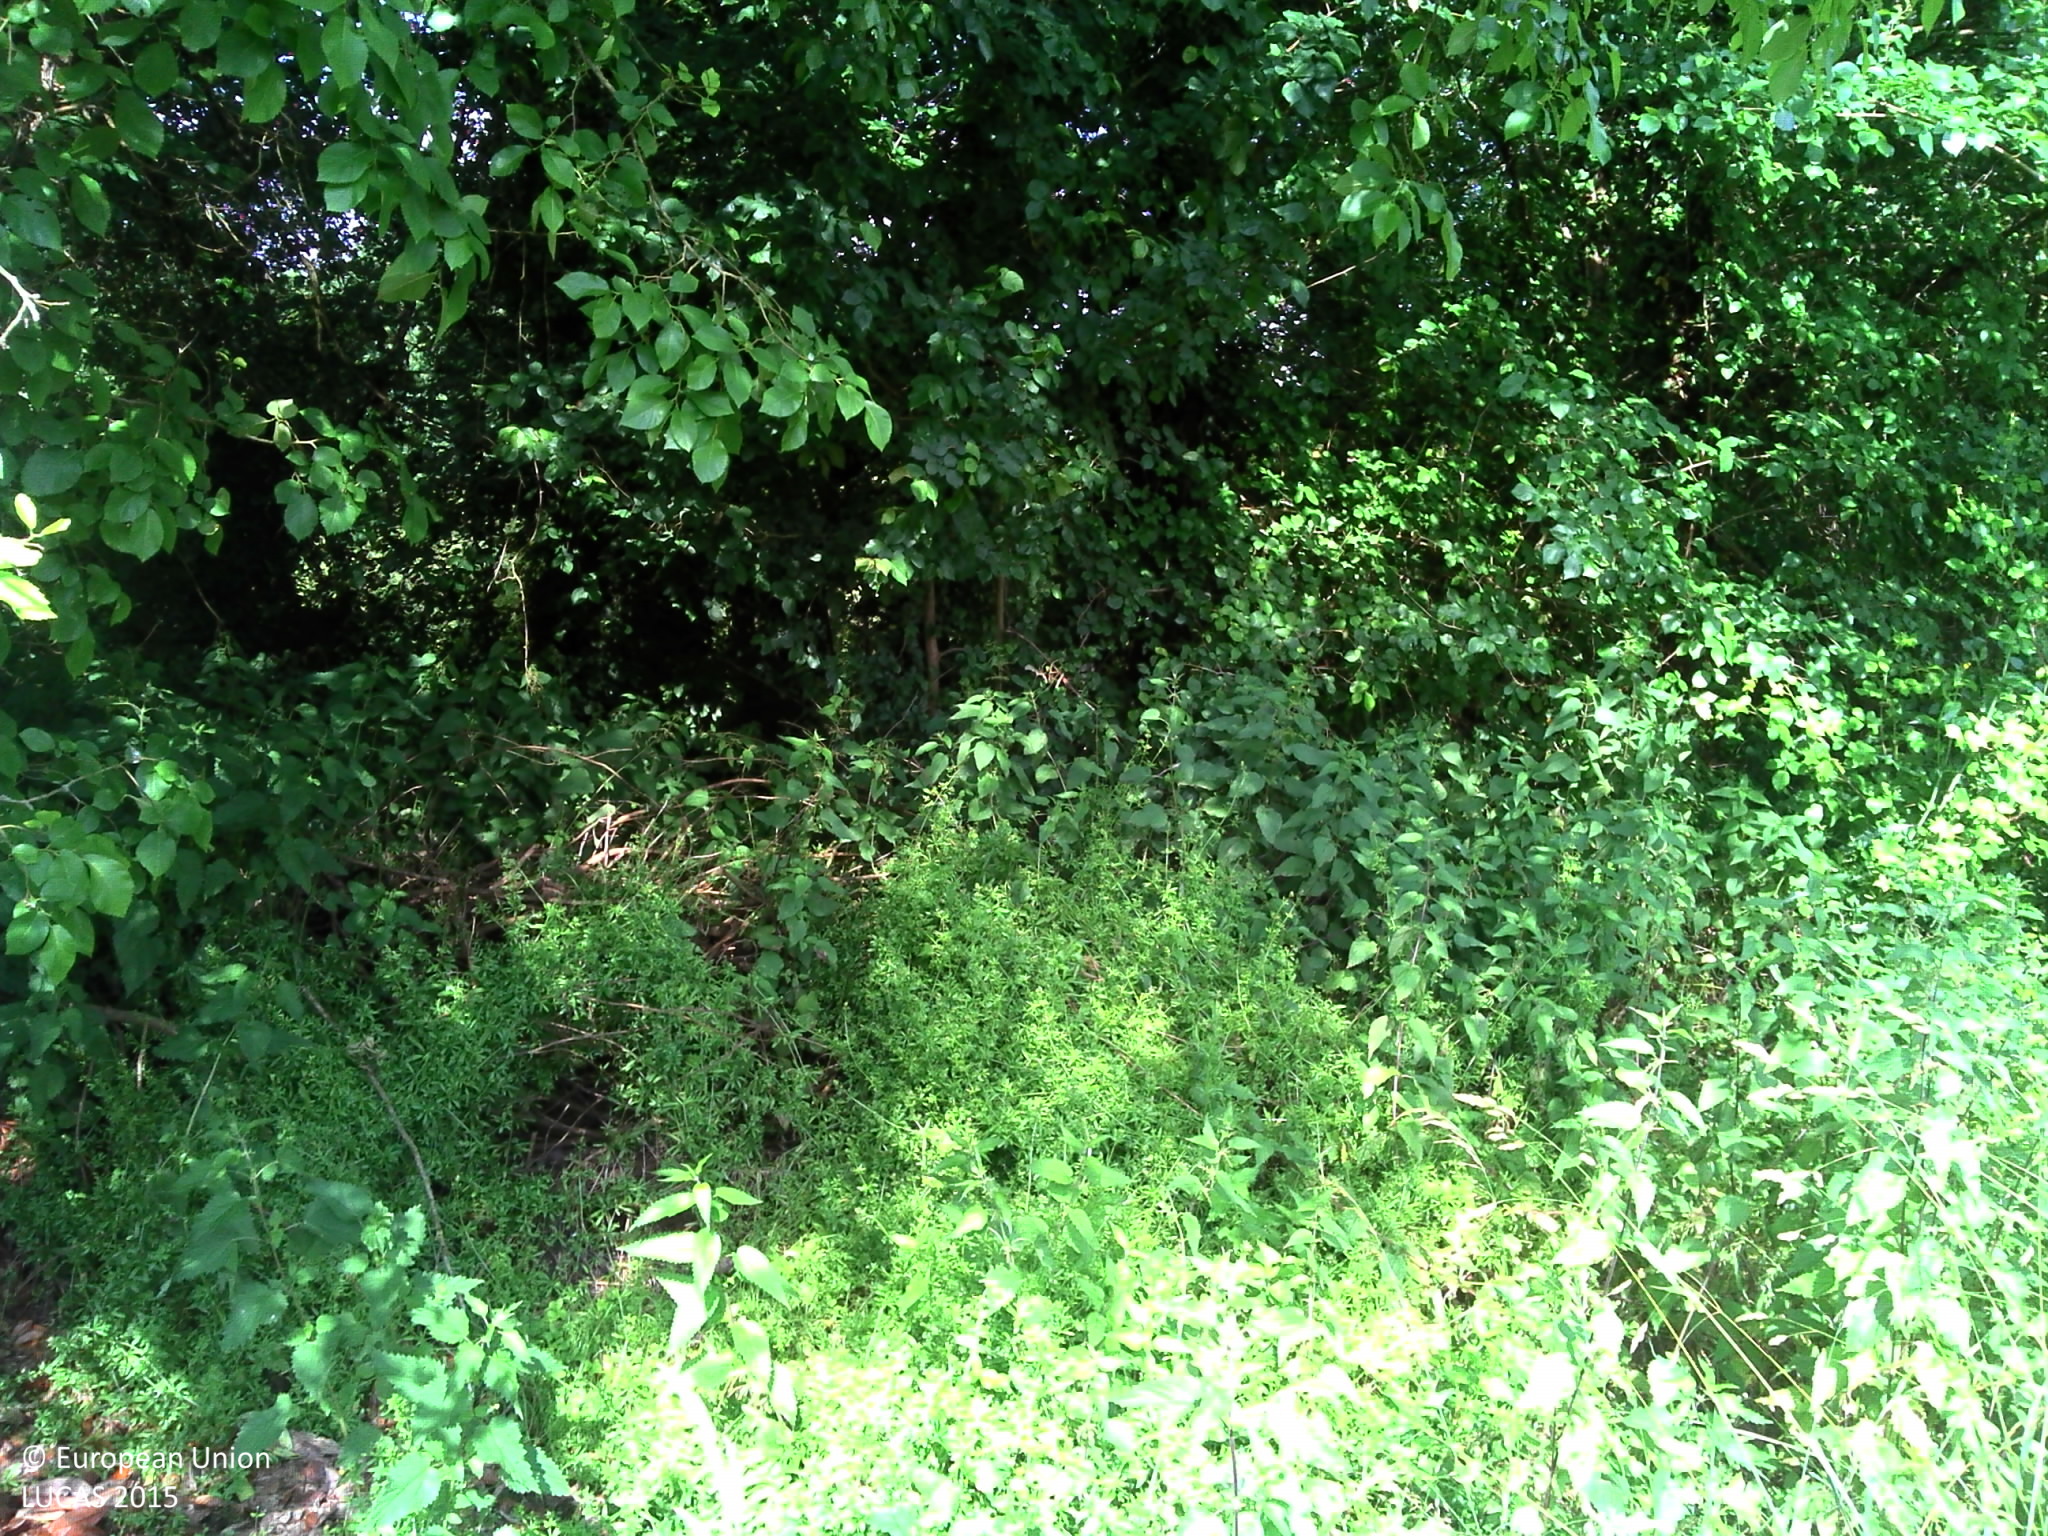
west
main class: Grassland
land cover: Grassland without tree/shrub cover
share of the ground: > 75 %
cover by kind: herbaceous plants 100 %
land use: Semi-natural and natural areas not in use
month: June
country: FR
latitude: 48.0845
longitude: -1.7415
